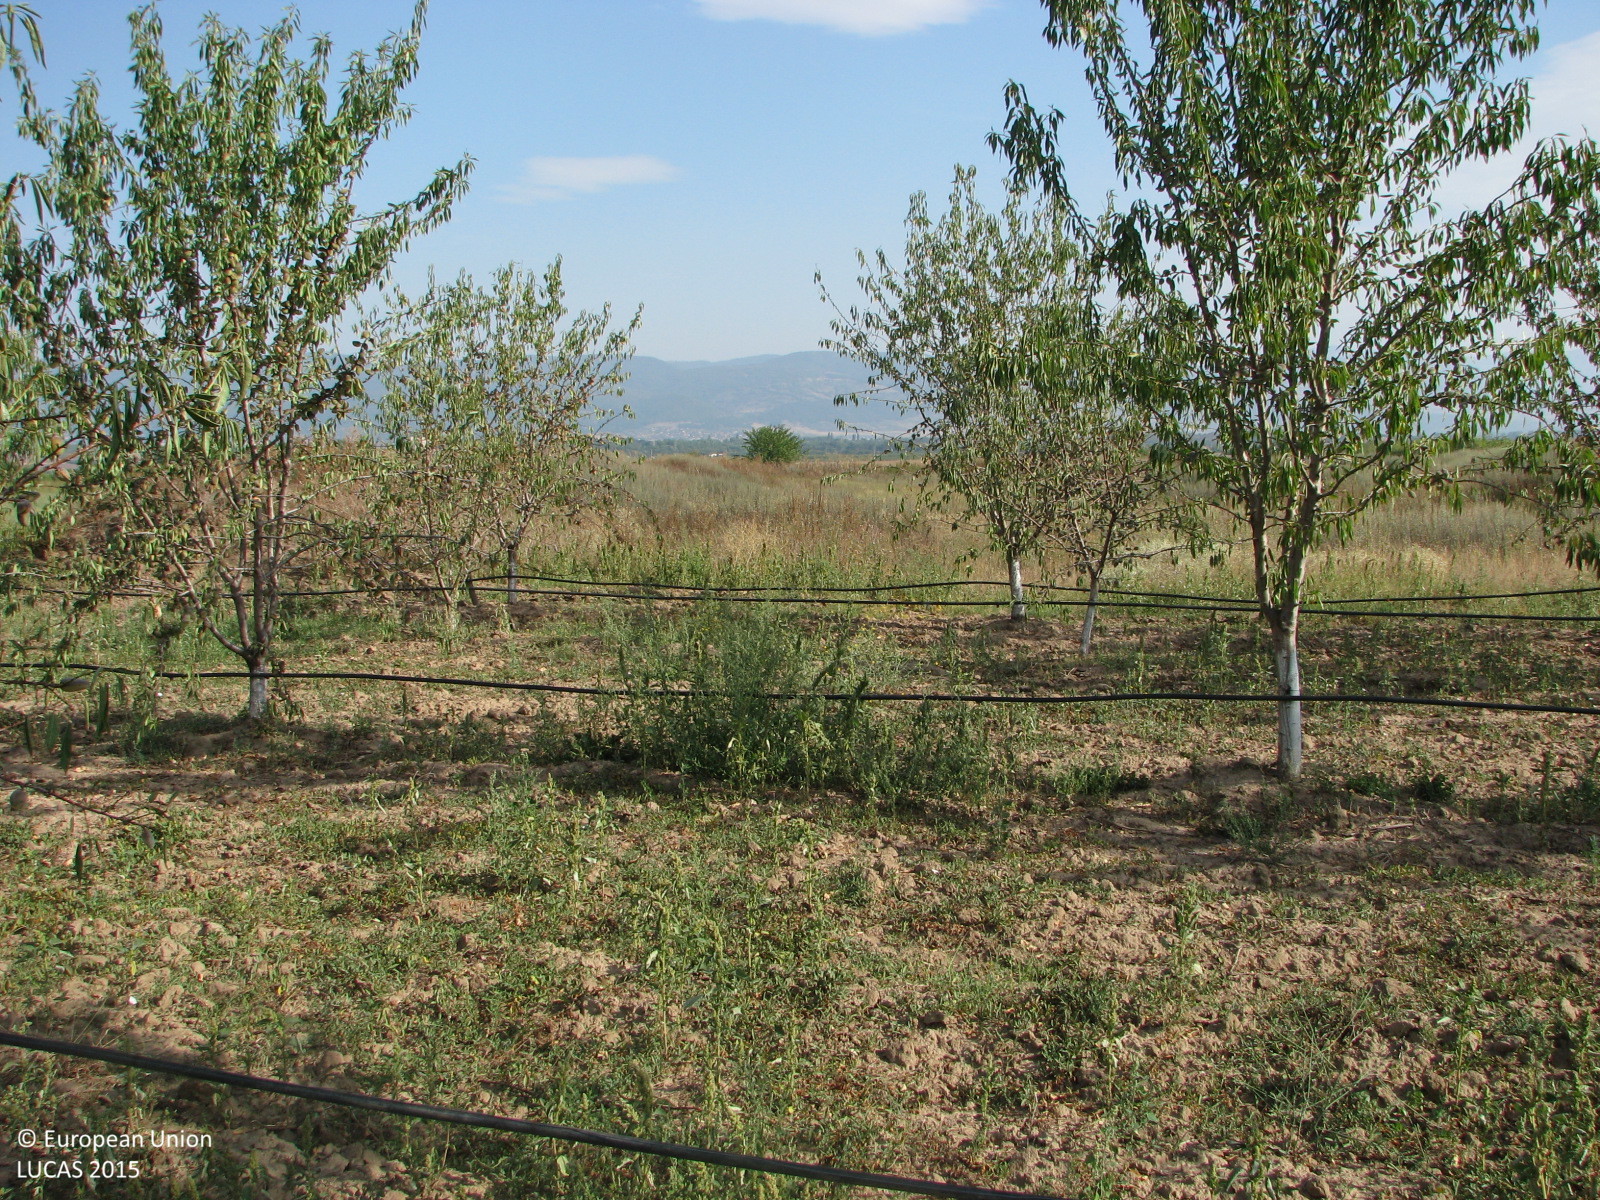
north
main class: Cropland
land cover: Nuts trees
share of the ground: 25 - 50 %
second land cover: Spontaneously vegetated surfaces
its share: 50 - 75 %
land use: Agriculture (excluding fallow land and kitchen gardens)
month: September
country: BG
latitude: 42.5844
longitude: 26.2322
